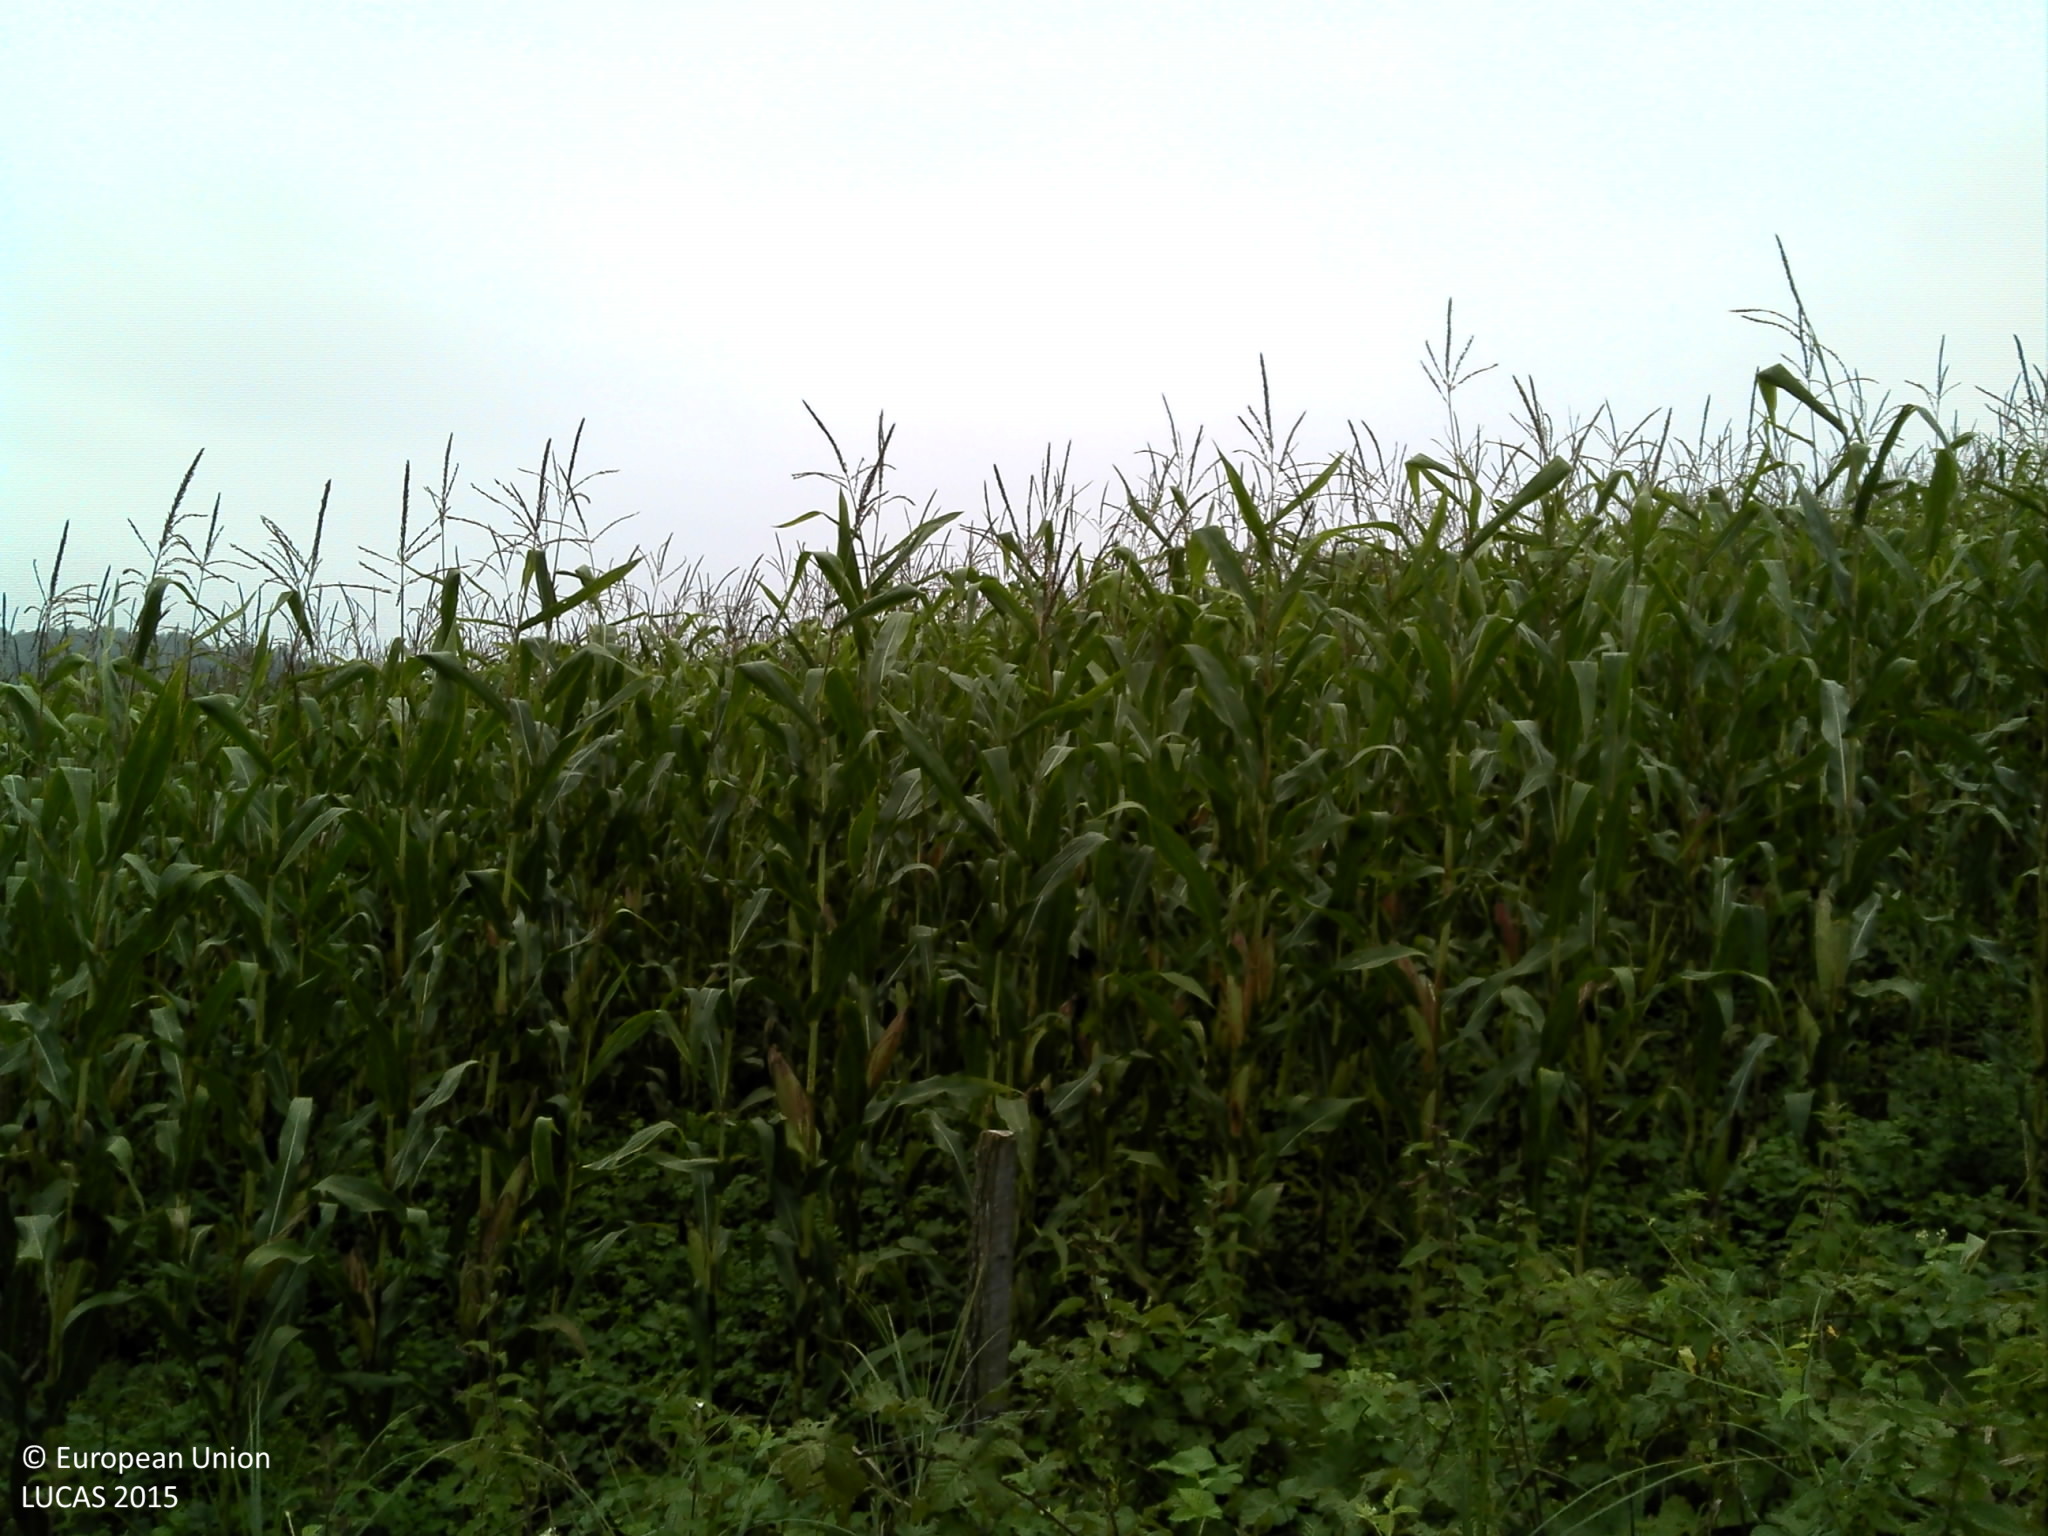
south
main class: Grassland
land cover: Spontaneously vegetated surfaces
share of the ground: > 75 %
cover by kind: herbaceous plants 100 %
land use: Semi-natural and natural areas not in use
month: August
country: HR
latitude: 45.2978
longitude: 15.6706
